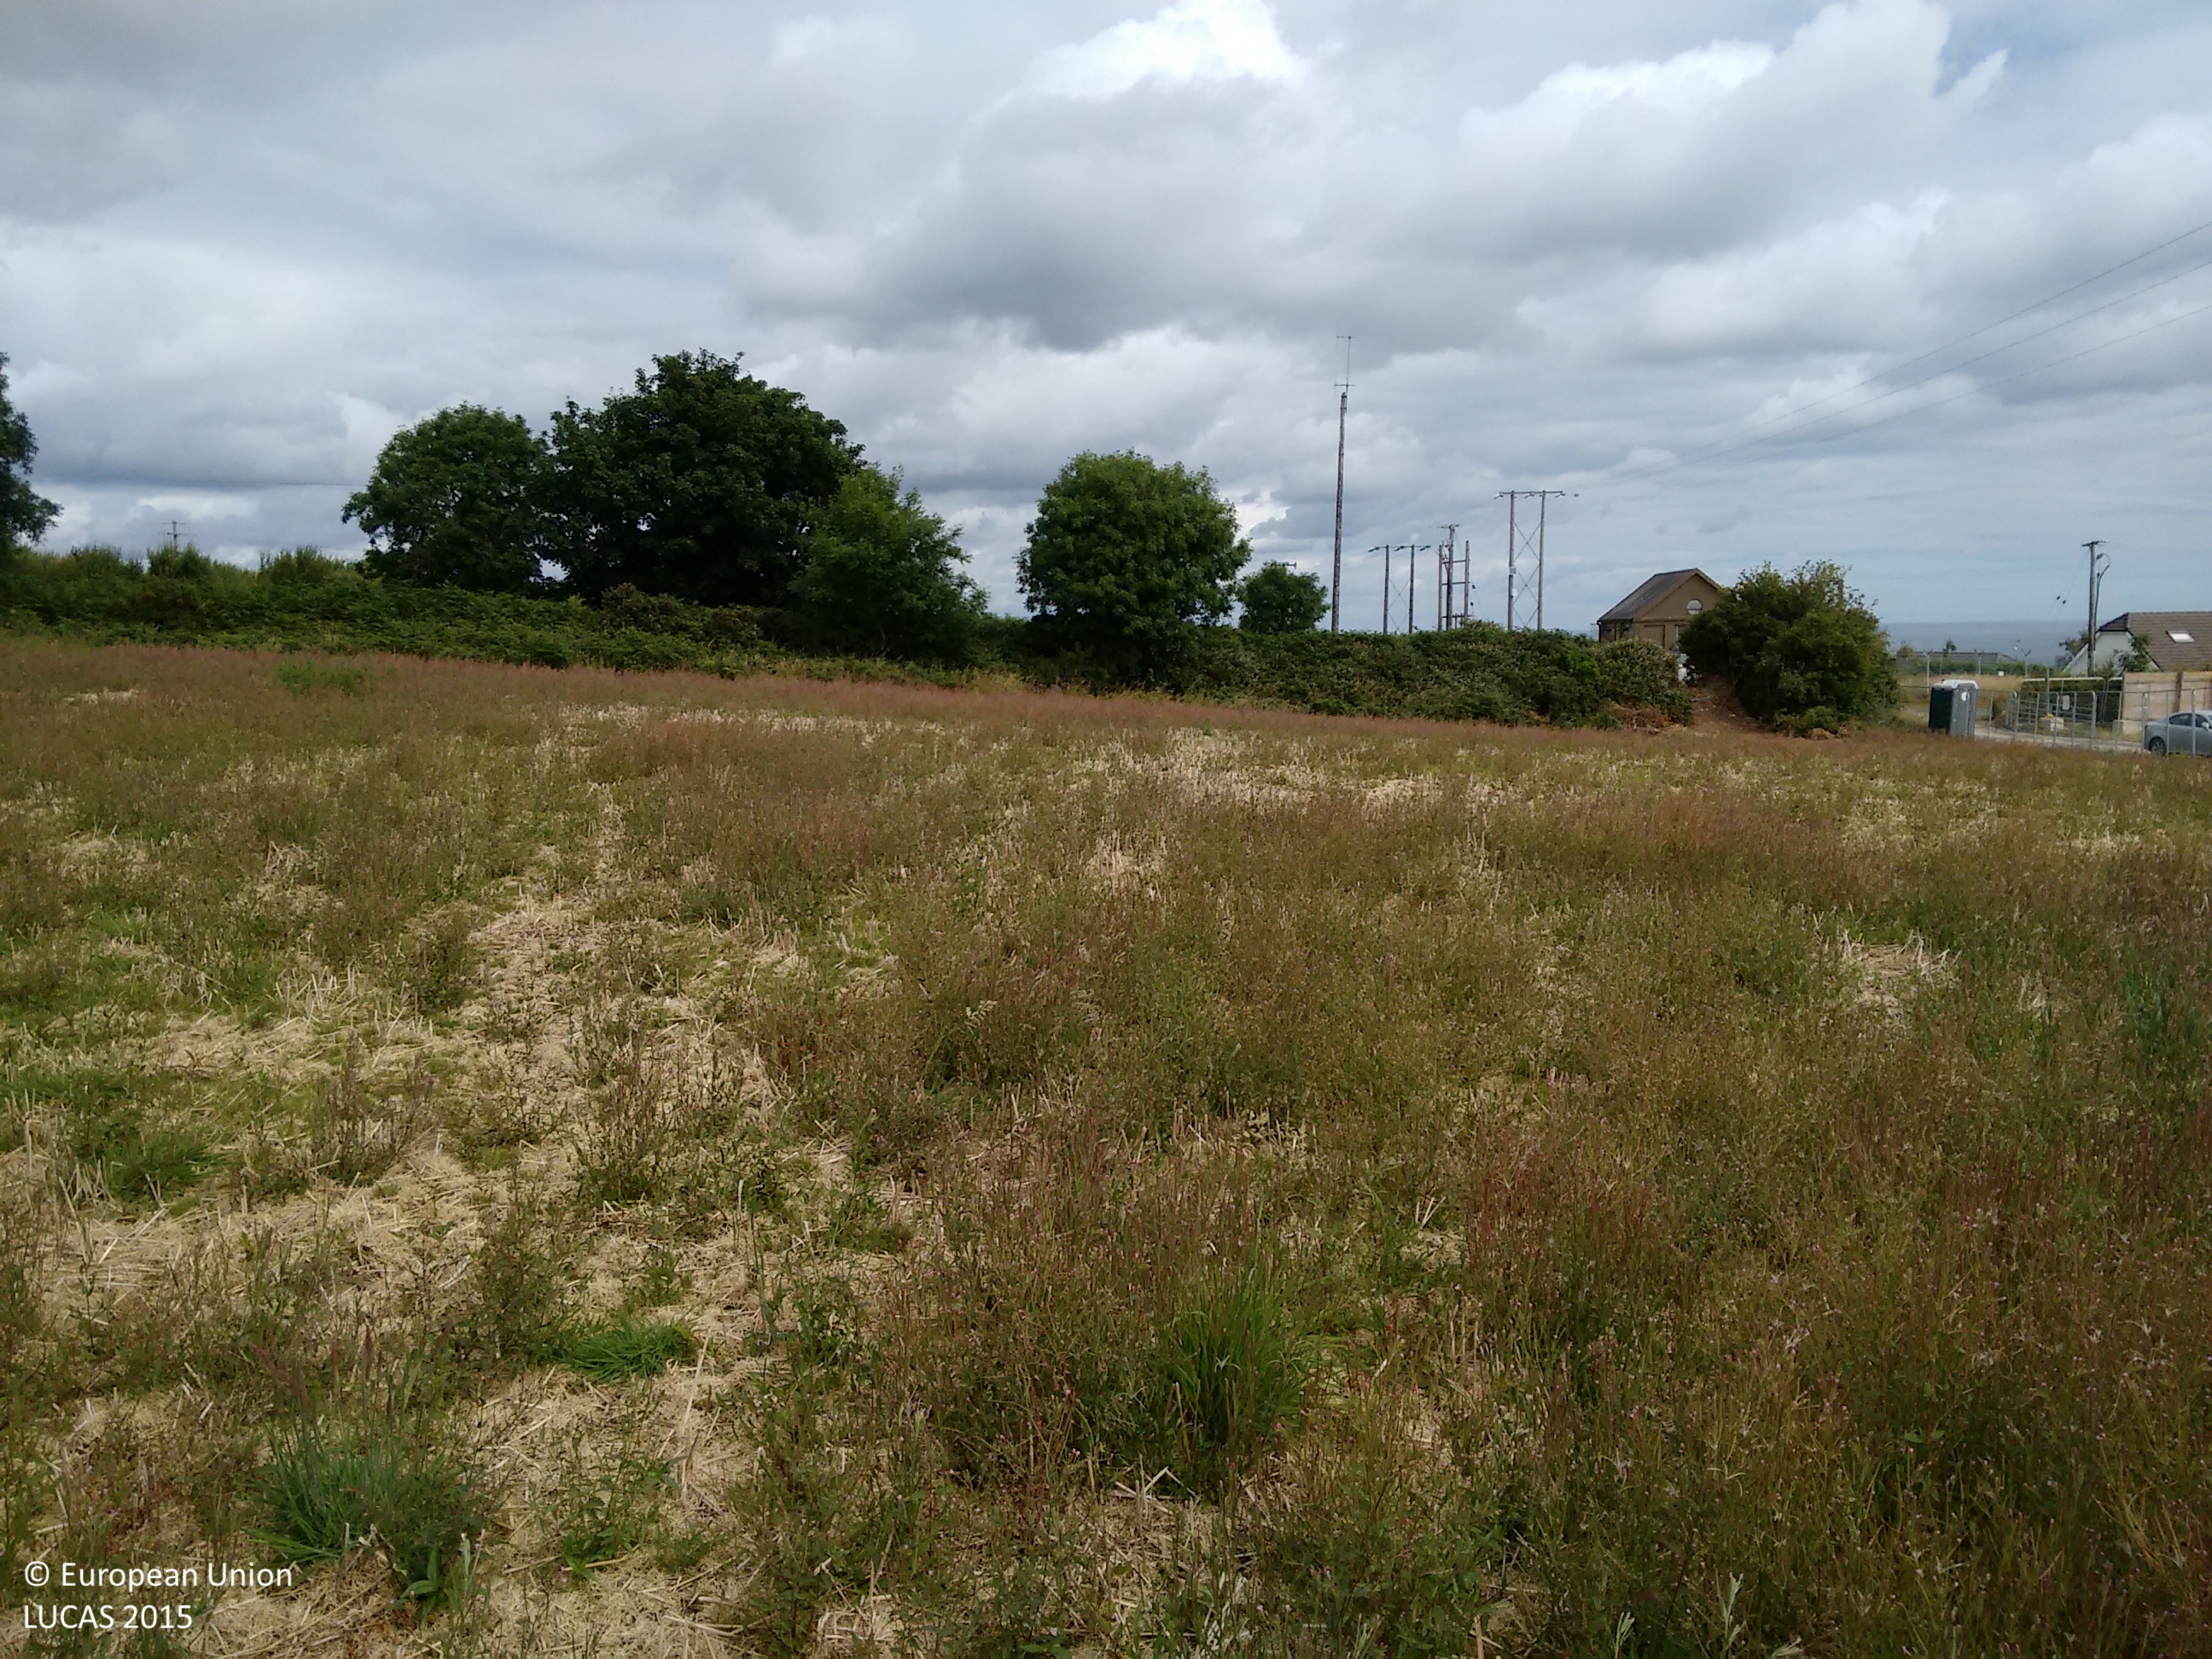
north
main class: Grassland
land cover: Spontaneously vegetated surfaces
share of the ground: > 75 %
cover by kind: herbaceous plants 80 %, unconsolidated bare surface 20 %
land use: Semi-natural and natural areas not in use
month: July
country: IE
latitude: 52.9797
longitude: -6.0660
